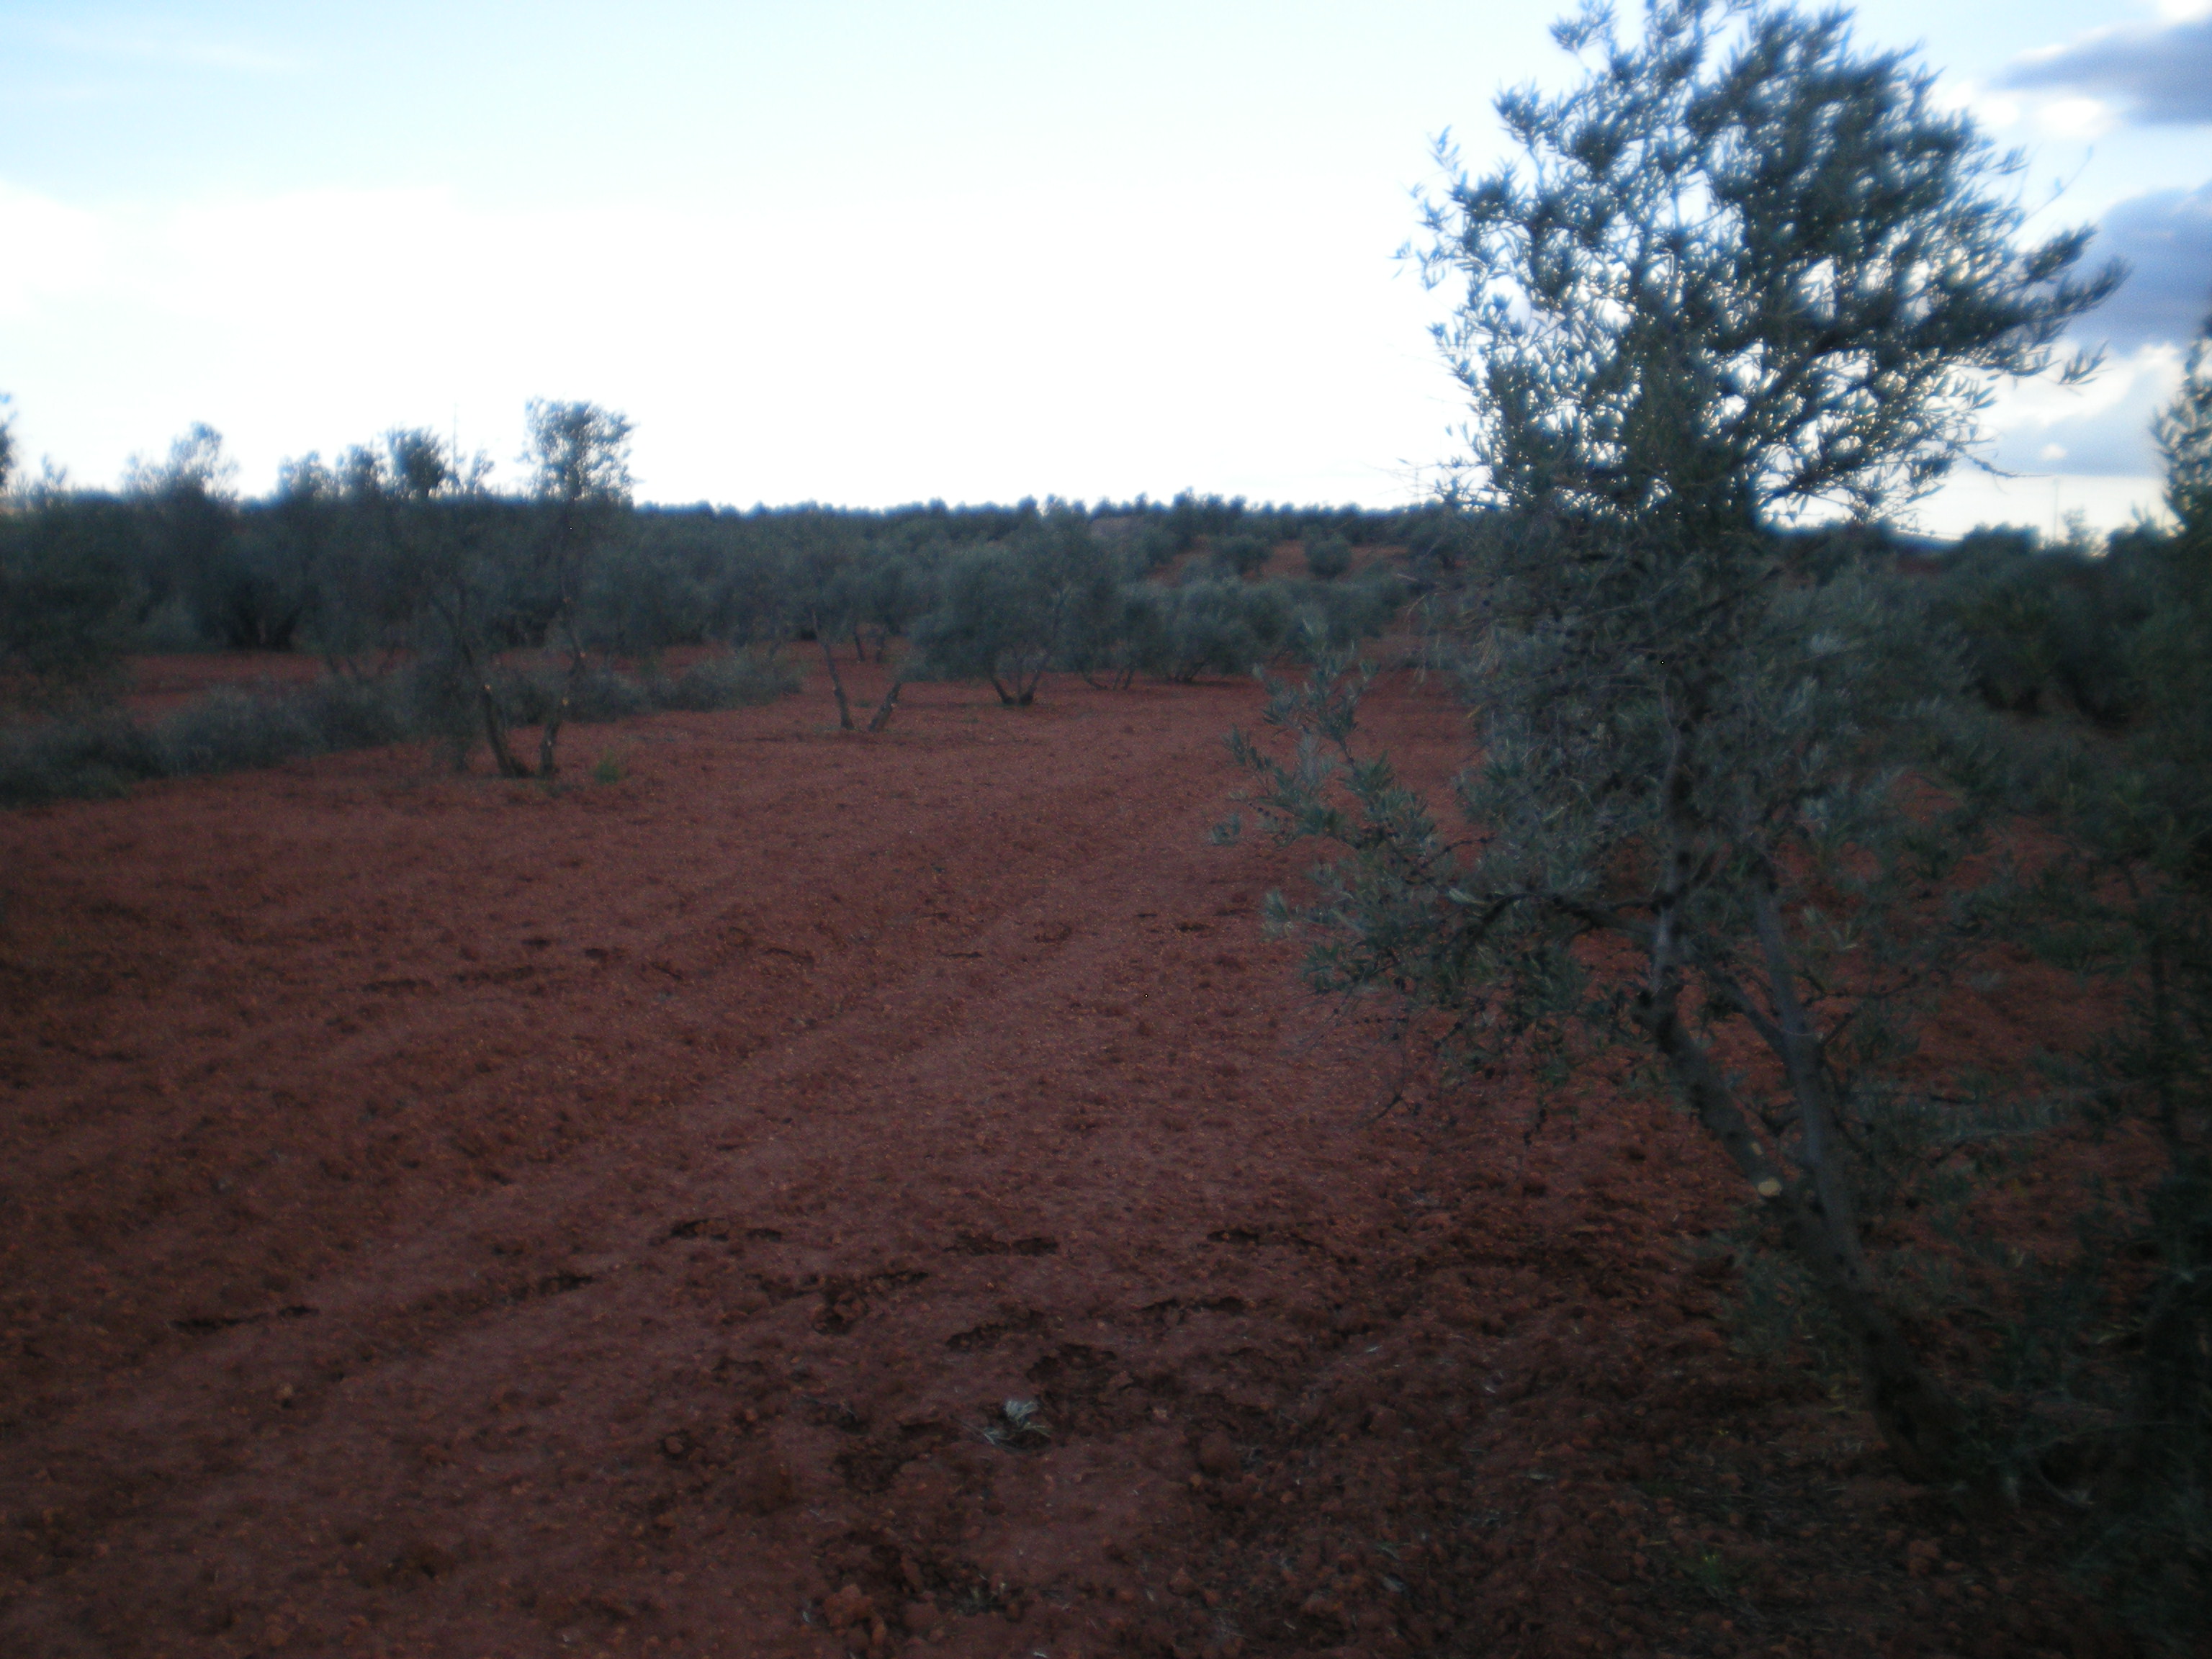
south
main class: Cropland
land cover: Olive groves
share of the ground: 10 - 25 %
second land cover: Other bare soil
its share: > 75 %
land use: Agriculture (excluding fallow land and kitchen gardens)
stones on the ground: < 10 %
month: April
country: ES
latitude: 38.6479
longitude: -3.3953
